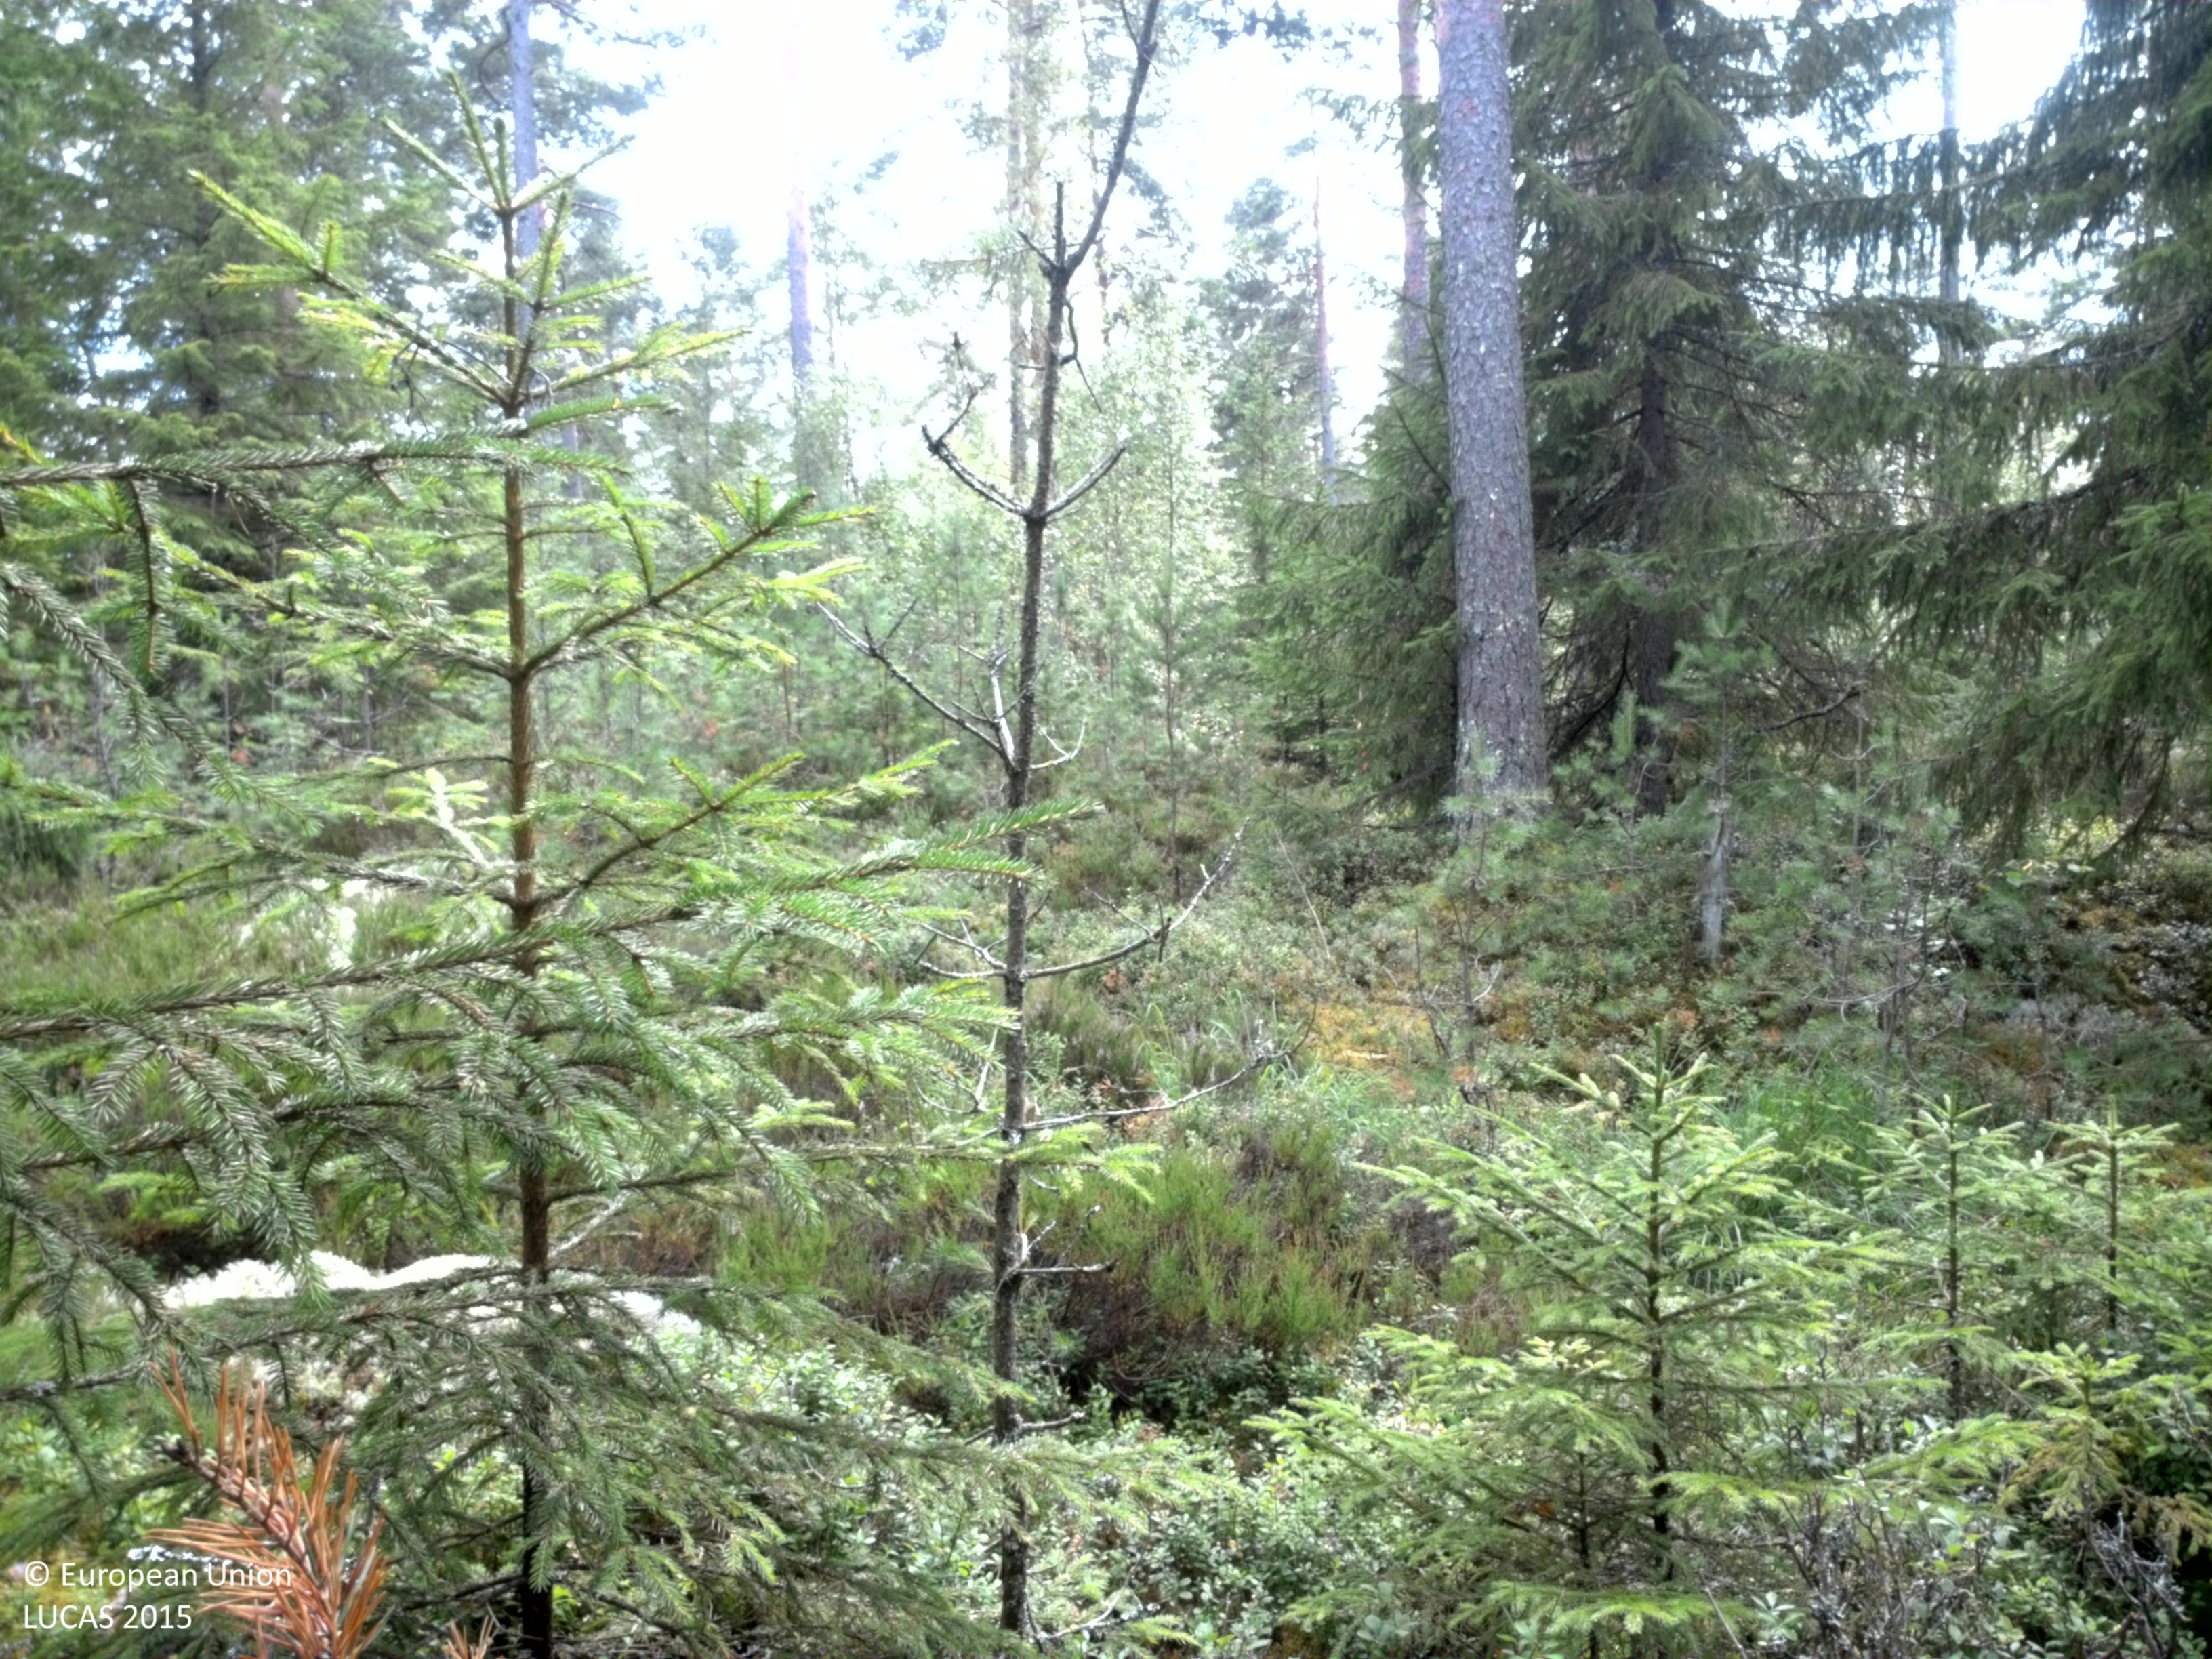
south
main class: Woodland
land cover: Pine dominated coniferous woodland
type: boreal forest
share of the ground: 25 - 50 %
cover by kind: coniferous forest trees 45 %, shrubs 30 %, lichens and mosses 20 %, broadleaved forest trees 5 %
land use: Forestry
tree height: > 5 m
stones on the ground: 25 - 50 %
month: August
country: SE
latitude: 59.4242
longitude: 13.1826
